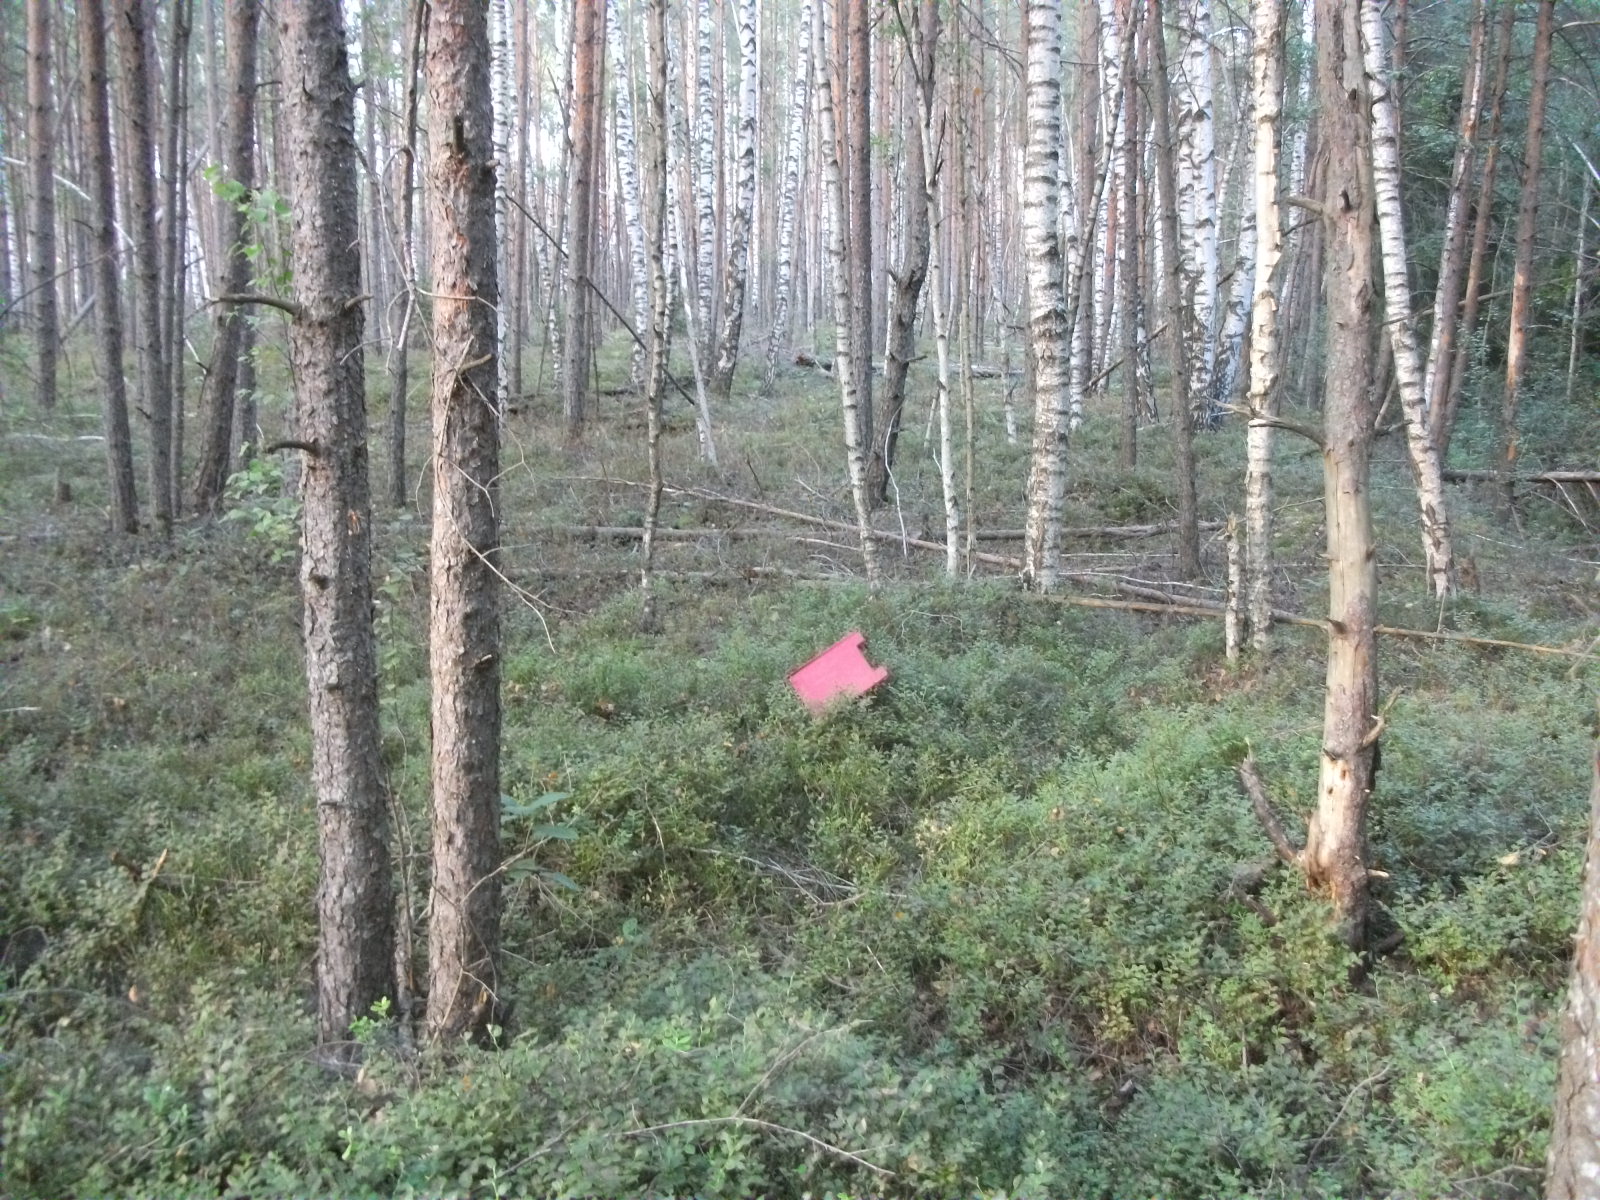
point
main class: Woodland
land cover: Pine dominated mixed woodland
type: hemiboreal forest and nemoral coniferous forest and mixed broadleaved-coniferous forest
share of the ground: > 75 %
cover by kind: coniferous forest trees 50 %, broadleaved forest trees 30 %, herbaceous plants 10 %, lichens and mosses 10 %
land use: Forestry
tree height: > 5 m
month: August
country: LV
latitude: 56.3653
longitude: 26.3148
